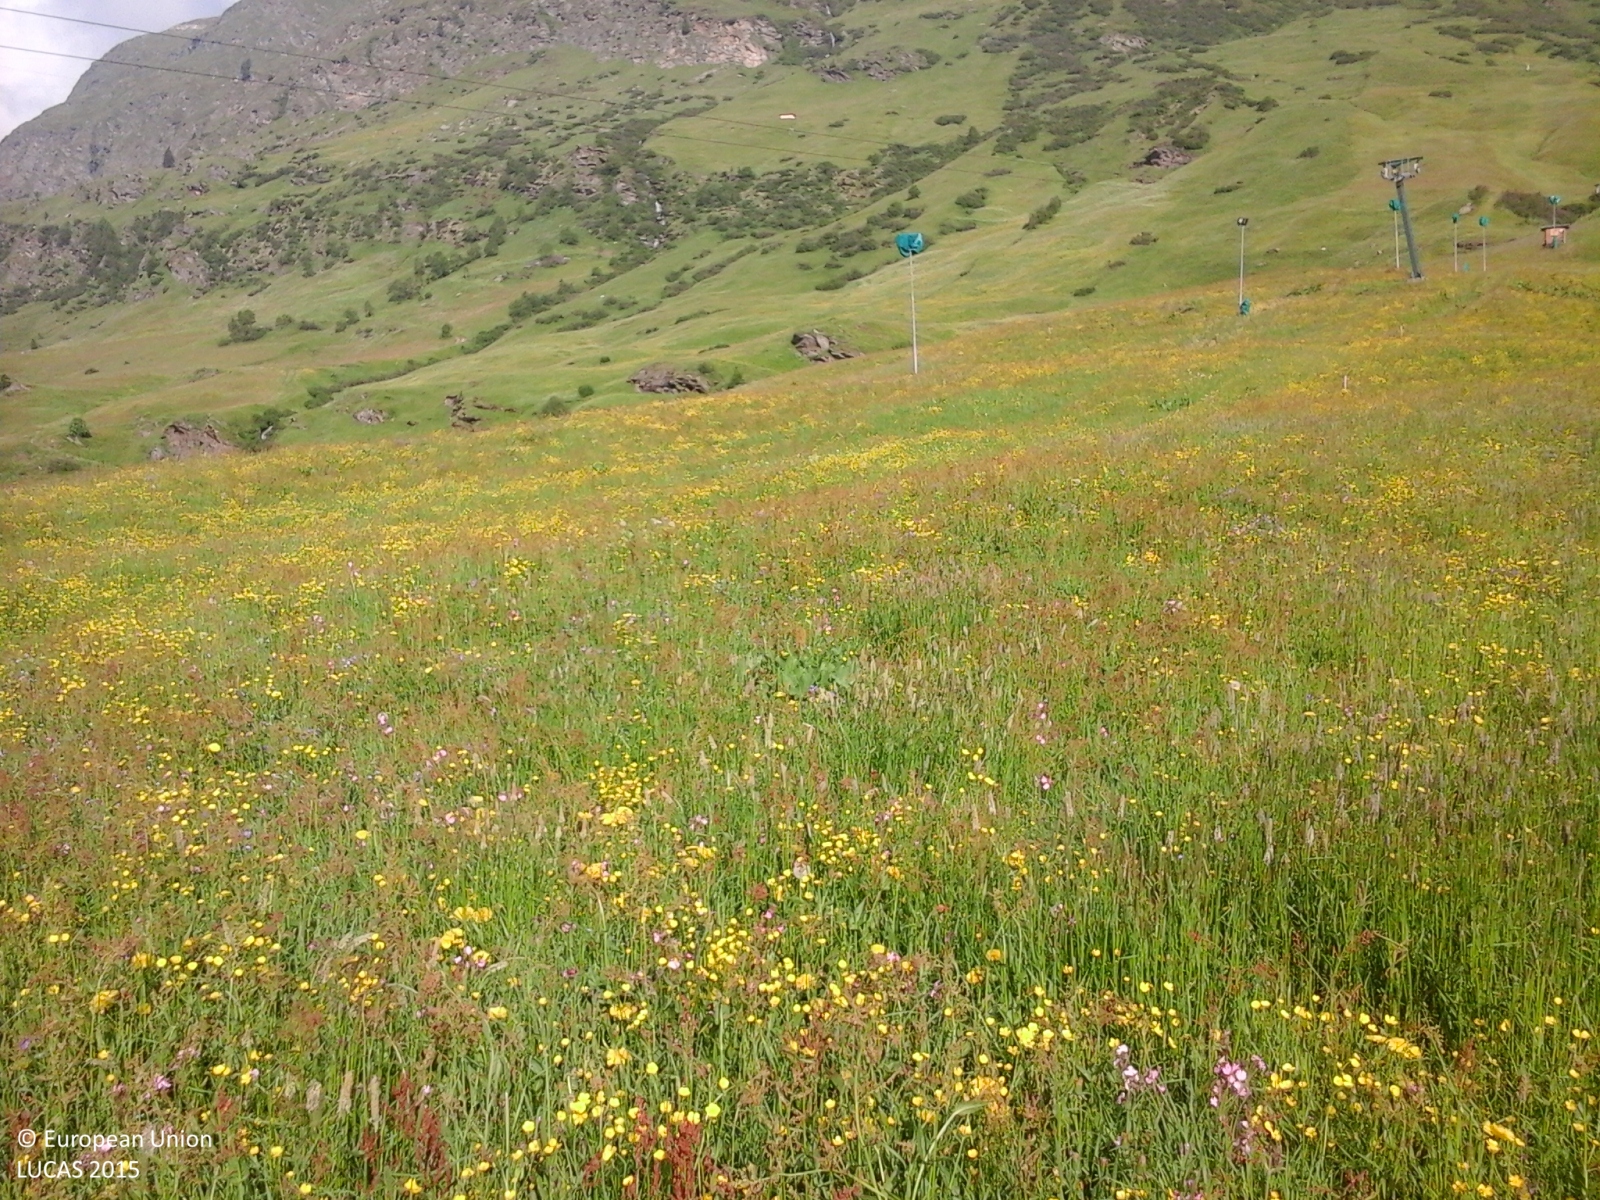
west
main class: Grassland
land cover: Grassland without tree/shrub cover
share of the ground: > 75 %
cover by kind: herbaceous plants 100 %
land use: Agriculture (excluding fallow land and kitchen gardens)
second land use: Sport
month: June
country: IT
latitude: 46.7960
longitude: 11.0862
